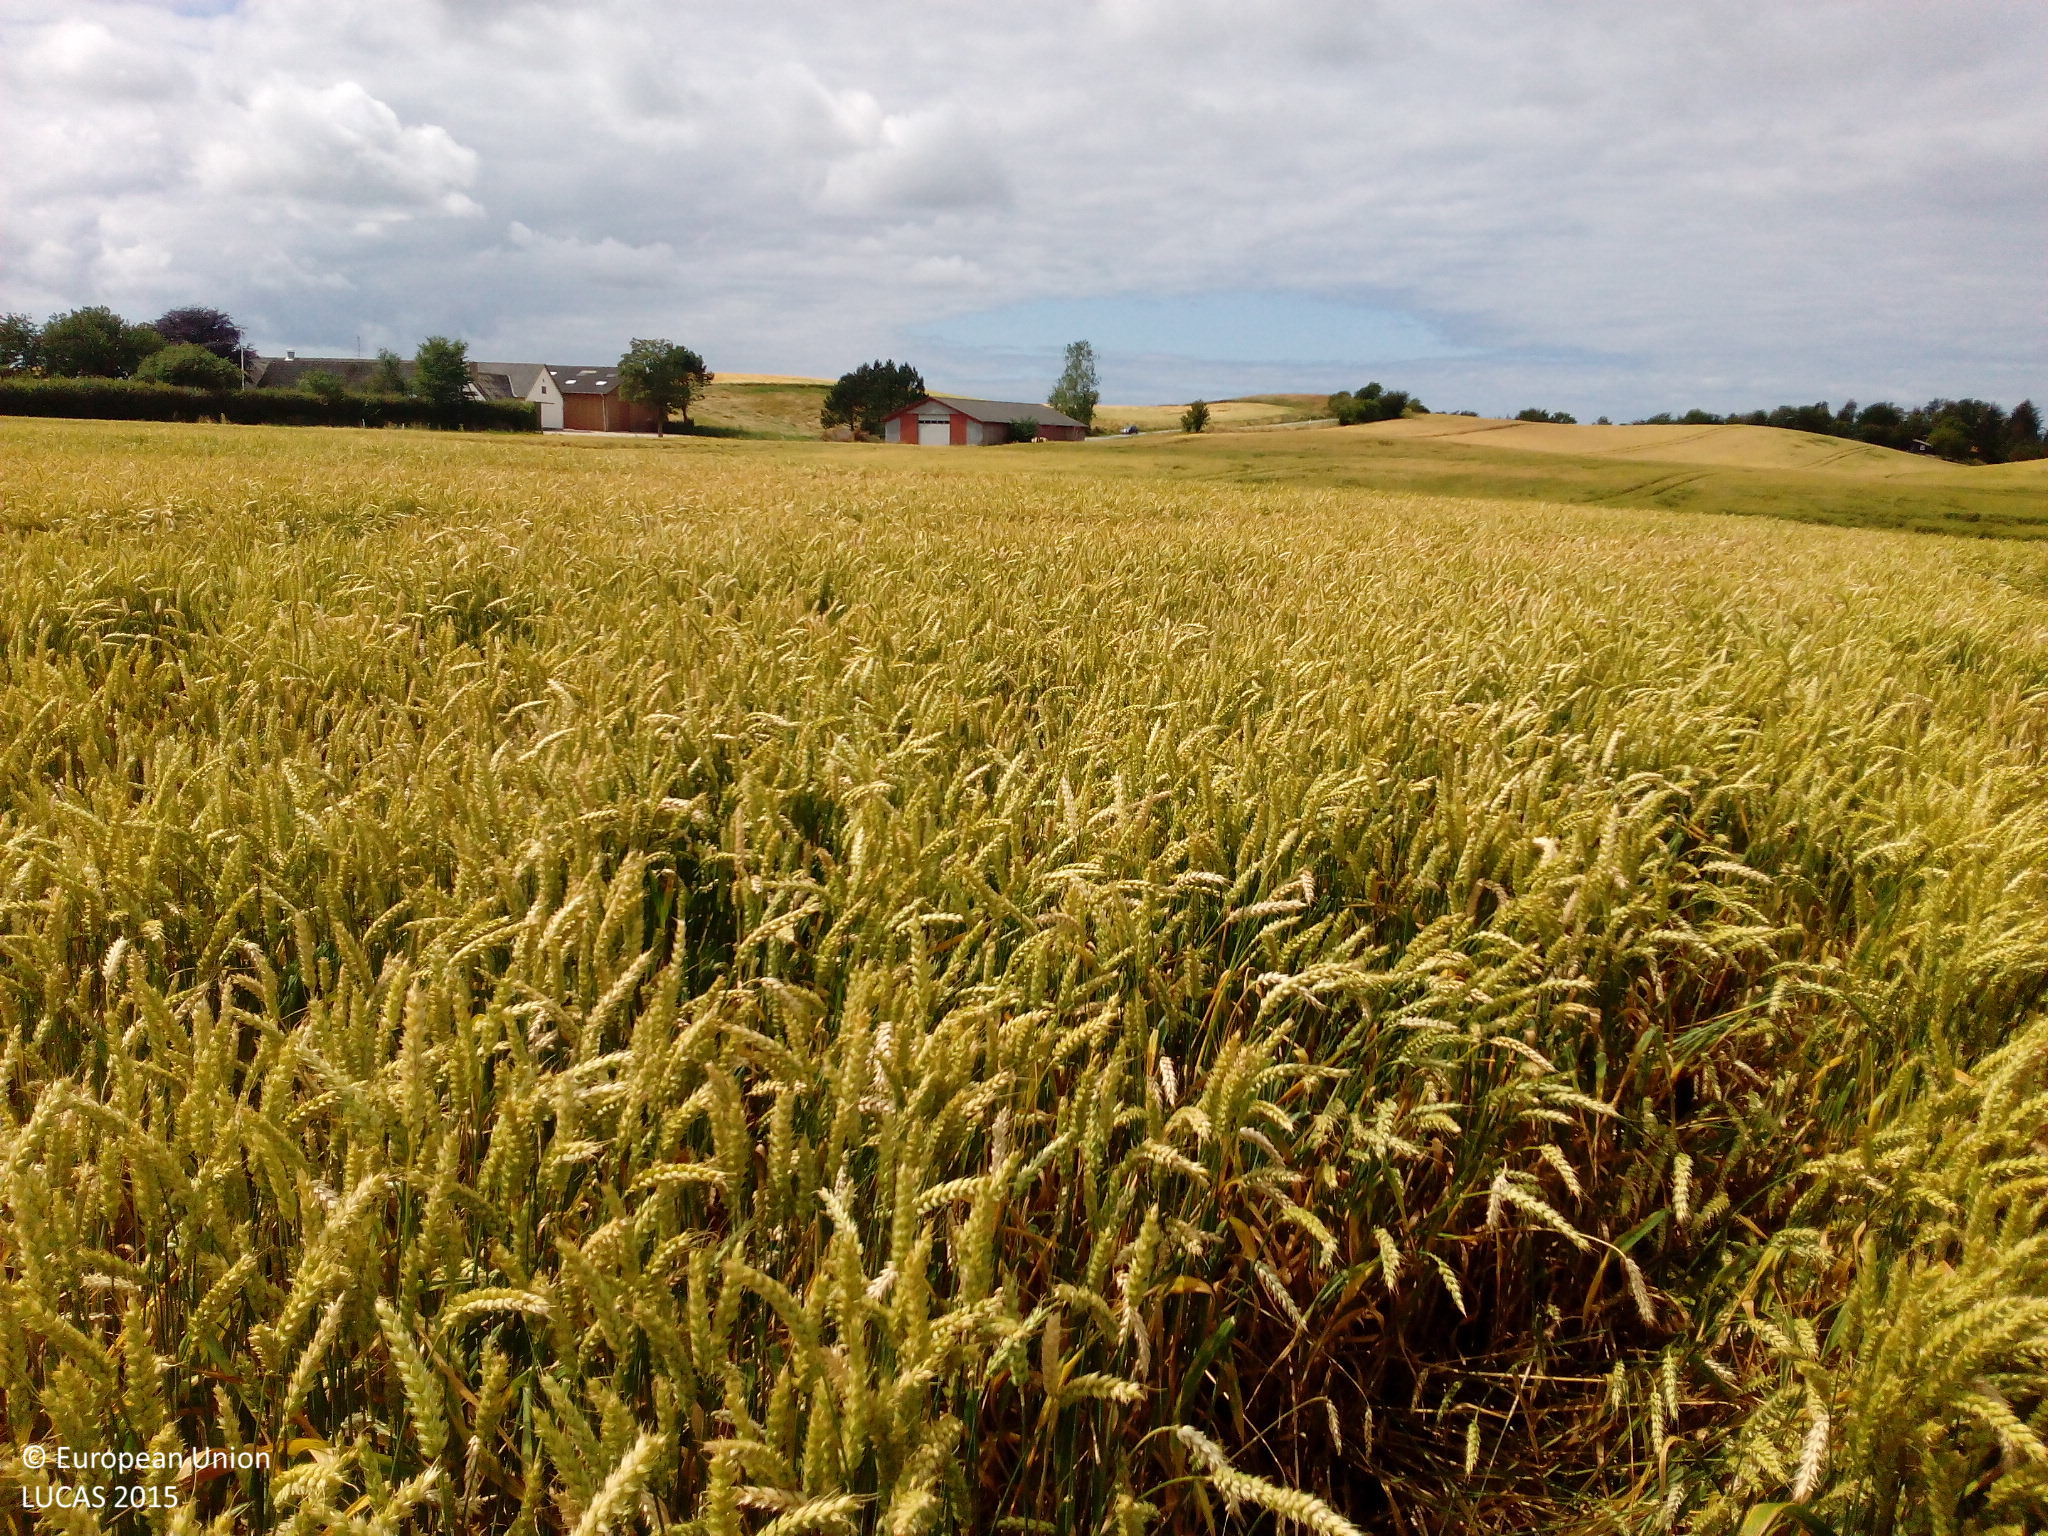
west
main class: Cropland
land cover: Common wheat
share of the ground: > 75 %
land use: Agriculture (excluding fallow land and kitchen gardens)
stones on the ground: < 10 %
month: July
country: DK
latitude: 55.9897
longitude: 12.1620
